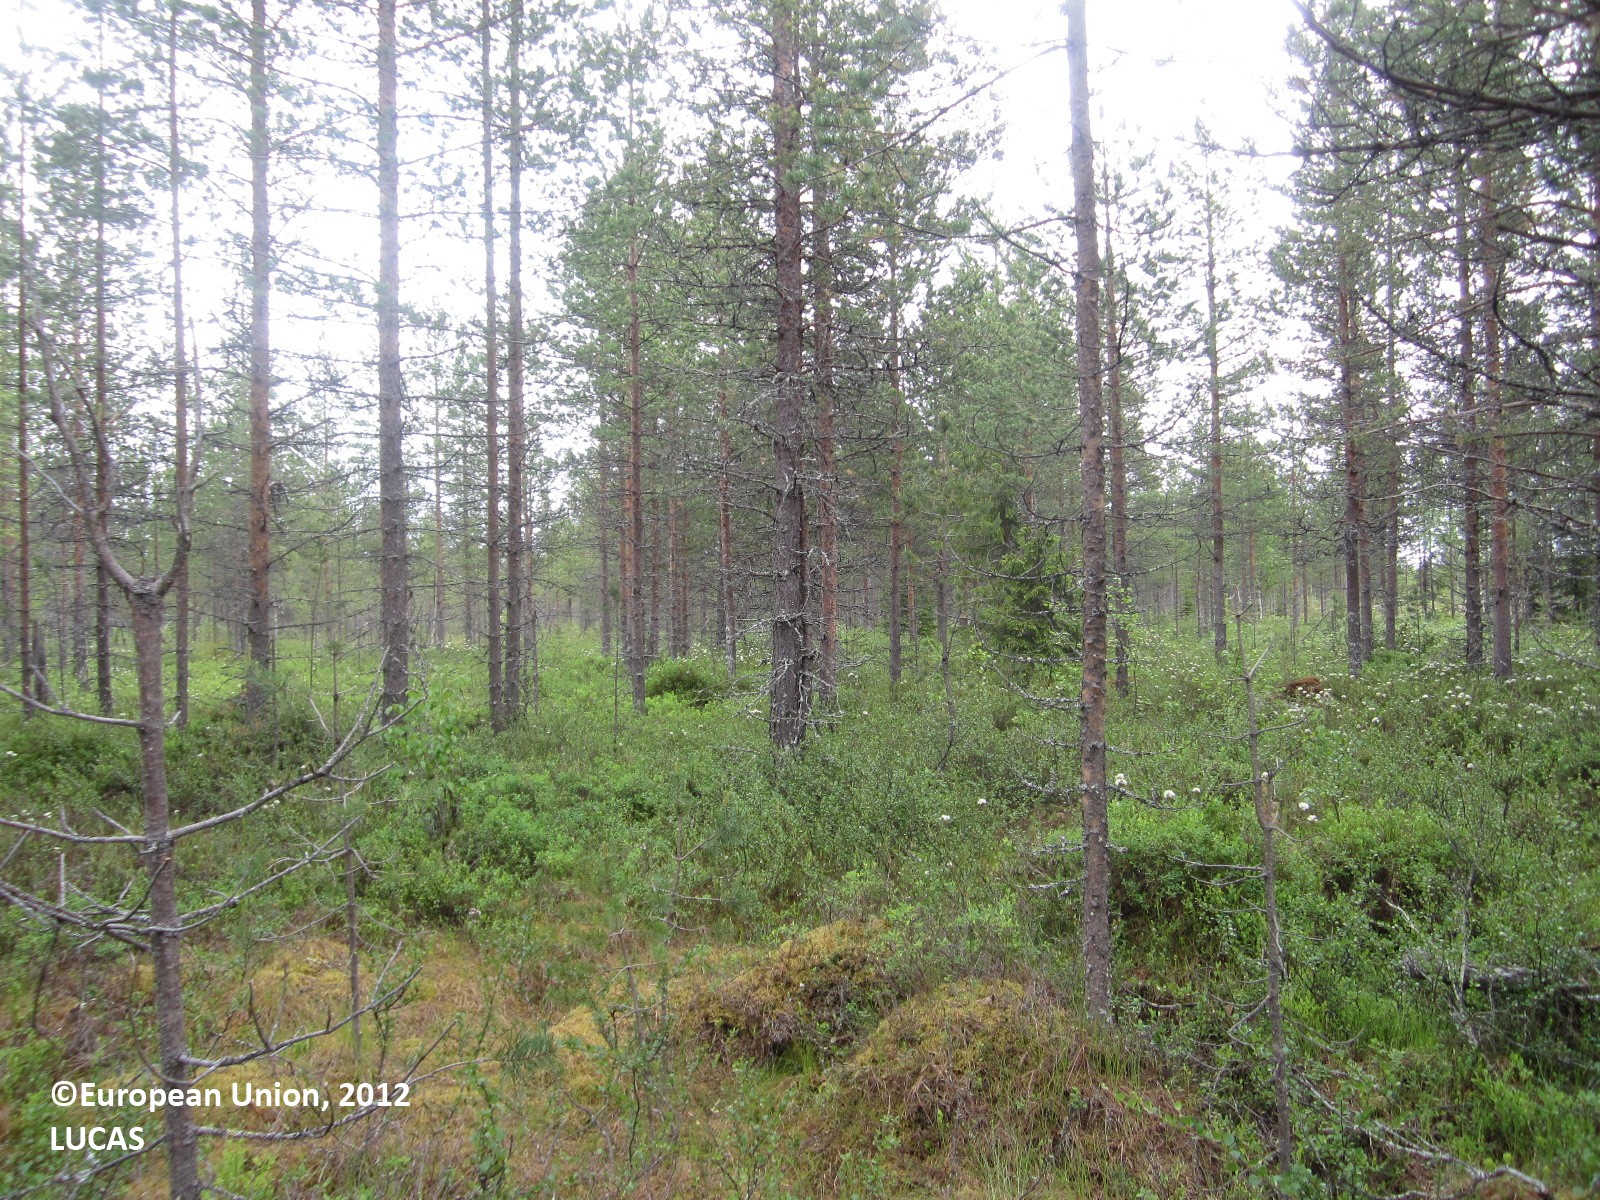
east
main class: Woodland
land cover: Pine dominated coniferous woodland
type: boreal forest
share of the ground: 50 - 75 %
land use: Forestry
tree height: > 5 m
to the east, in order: Pine dominated coniferous woodland; Ditches and canals; Pine dominated coniferous woodland; Ditches and canals; Pine dominated coniferous woodland; Tracks
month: June
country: FI
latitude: 64.7455
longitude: 29.7787
